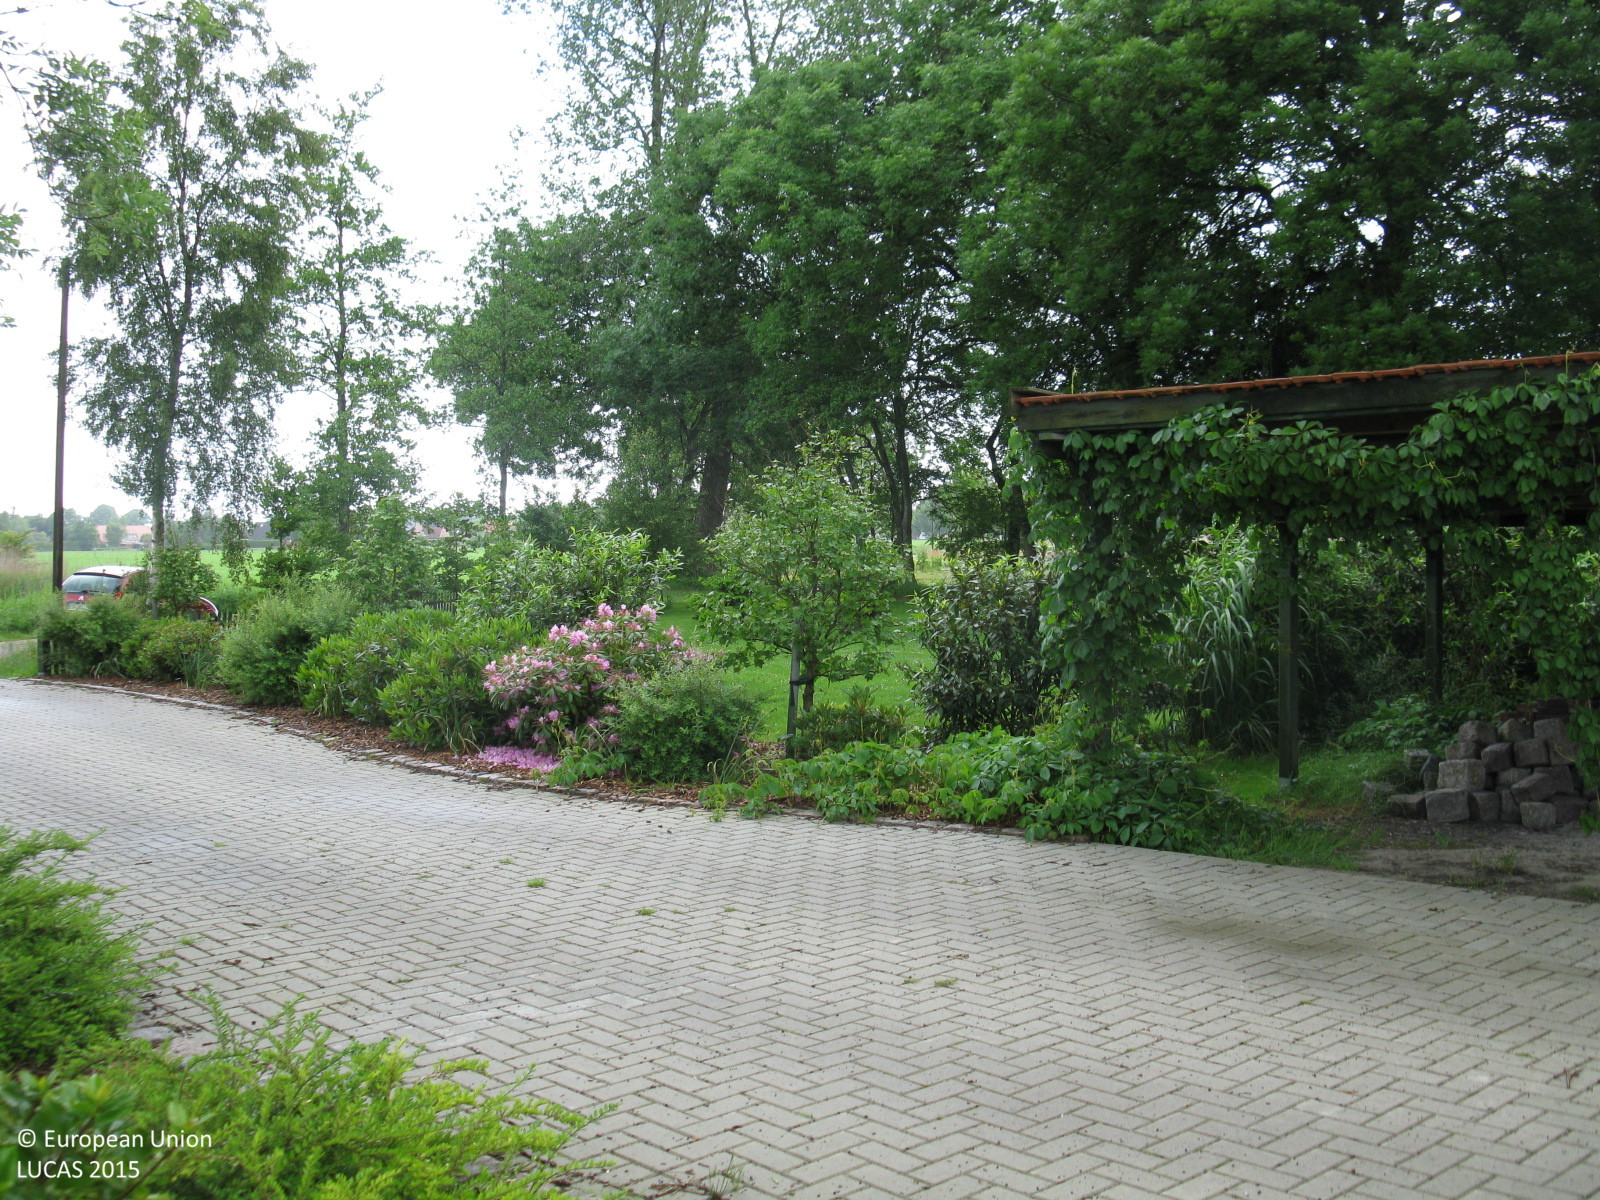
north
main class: Cropland
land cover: Floriculture and ornamental plants
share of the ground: > 75 %
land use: Residential
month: June
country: DE
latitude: 53.5171
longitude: 7.3614
